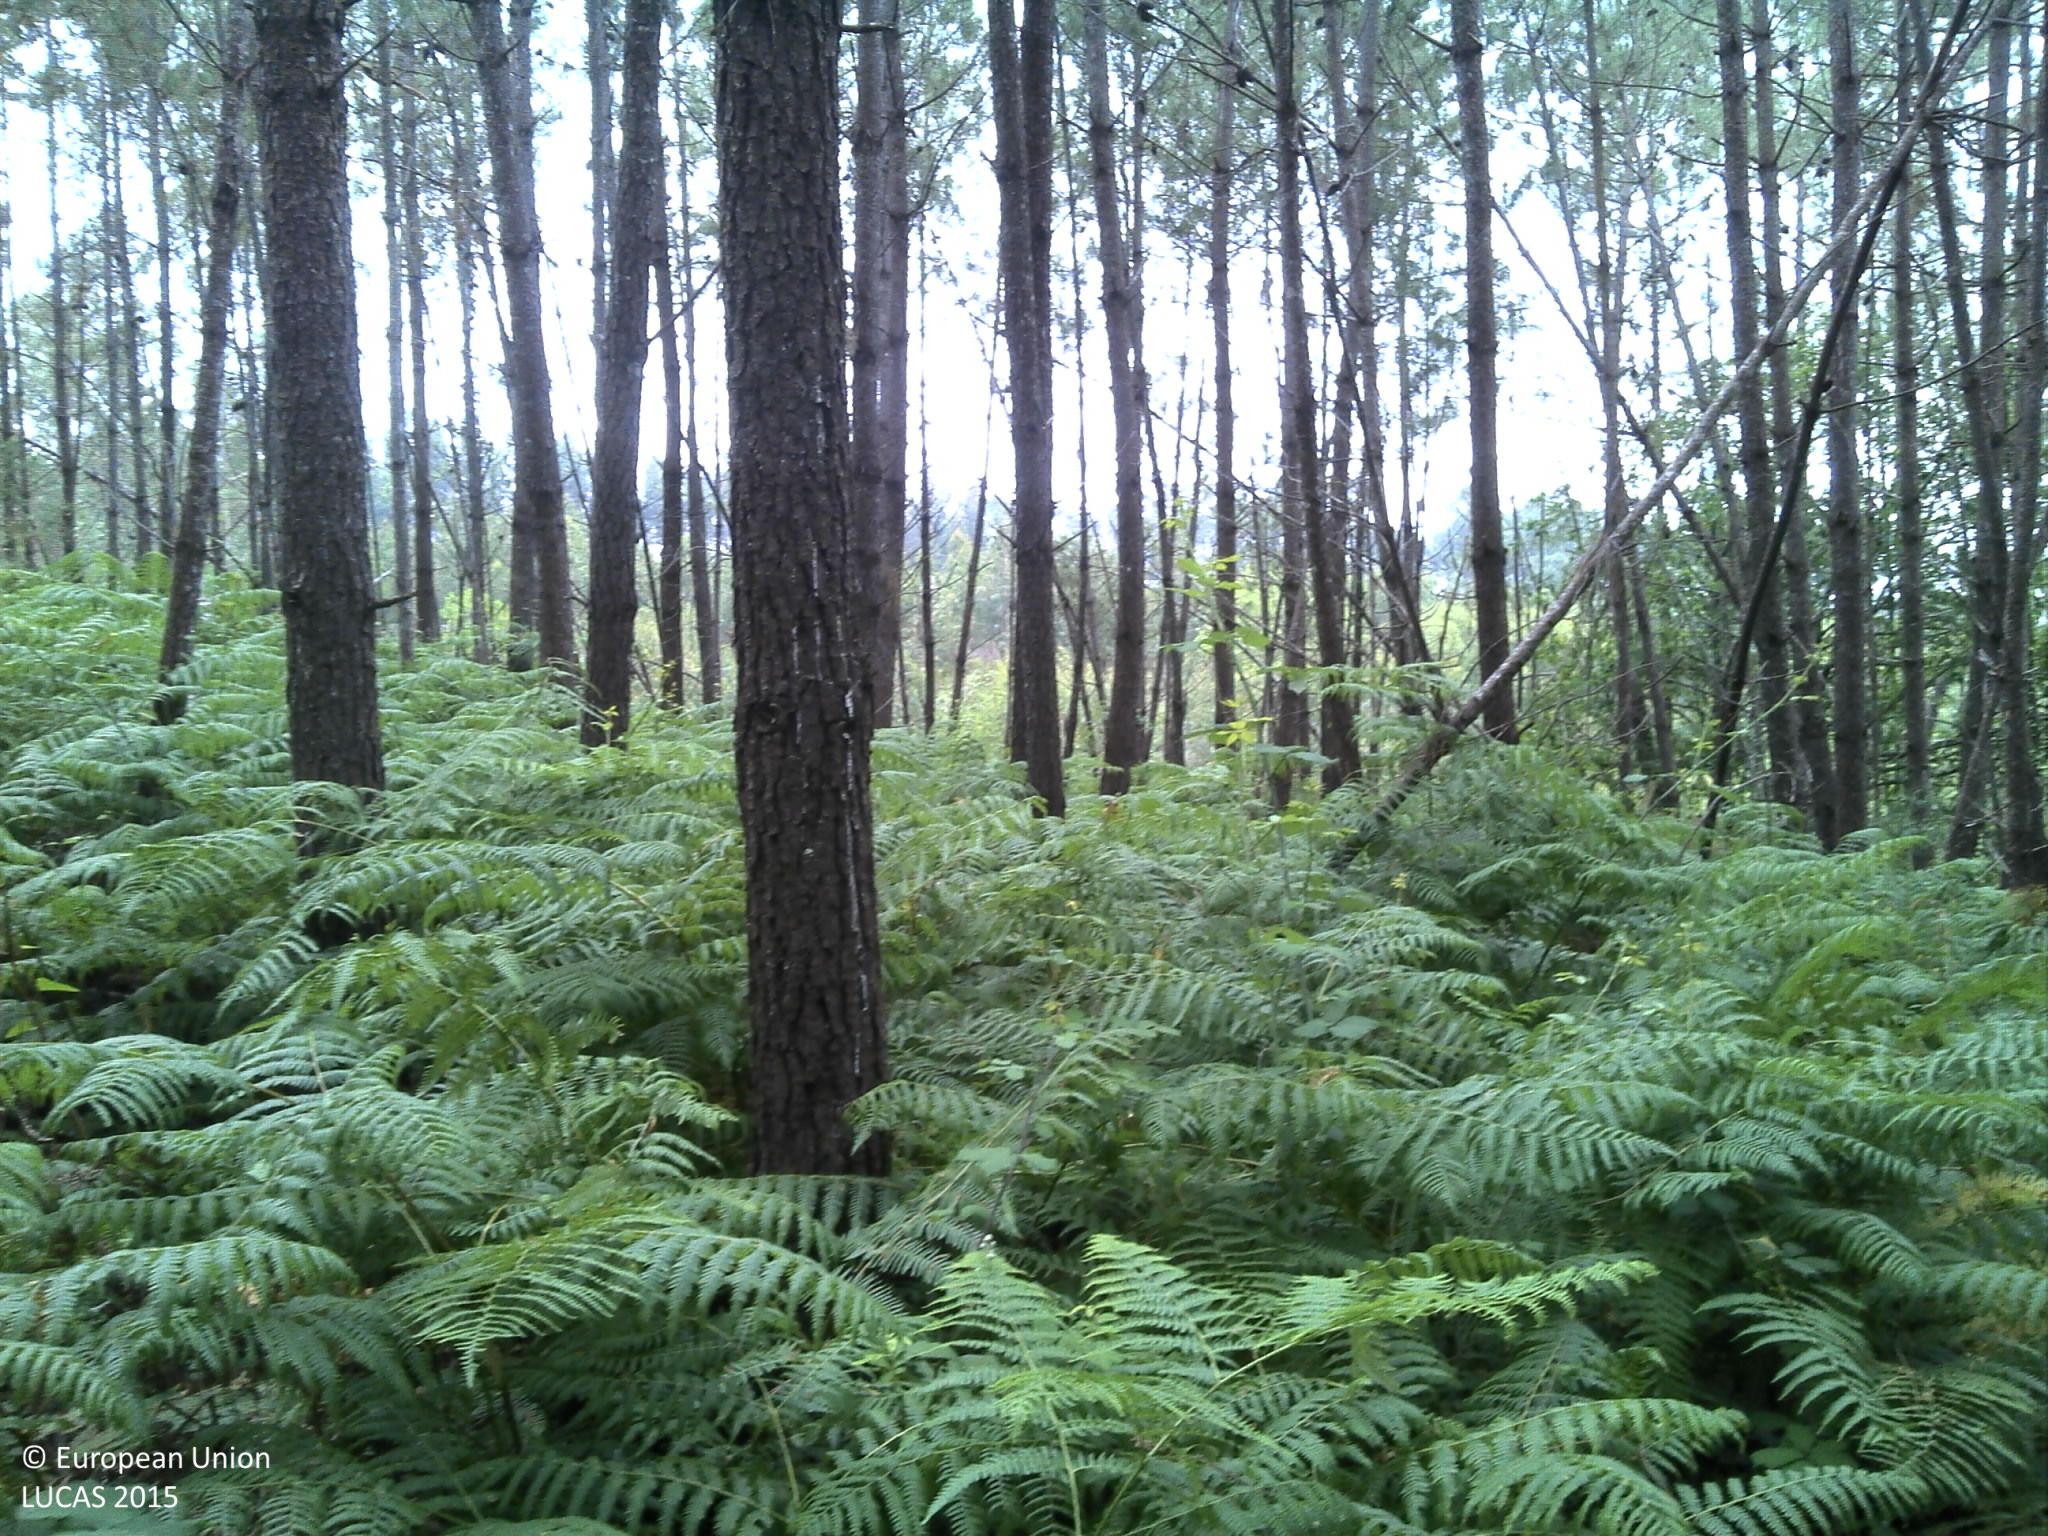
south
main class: Woodland
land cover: Pine dominated coniferous woodland
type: coniferous forest of the mediterranean region
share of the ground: 50 - 75 %
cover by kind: coniferous forest trees 60 %, shrubs 25 %, unconsolidated bare surface 15 %
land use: Forestry
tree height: > 5 m
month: June
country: PT
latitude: 40.2682
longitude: -8.6835
